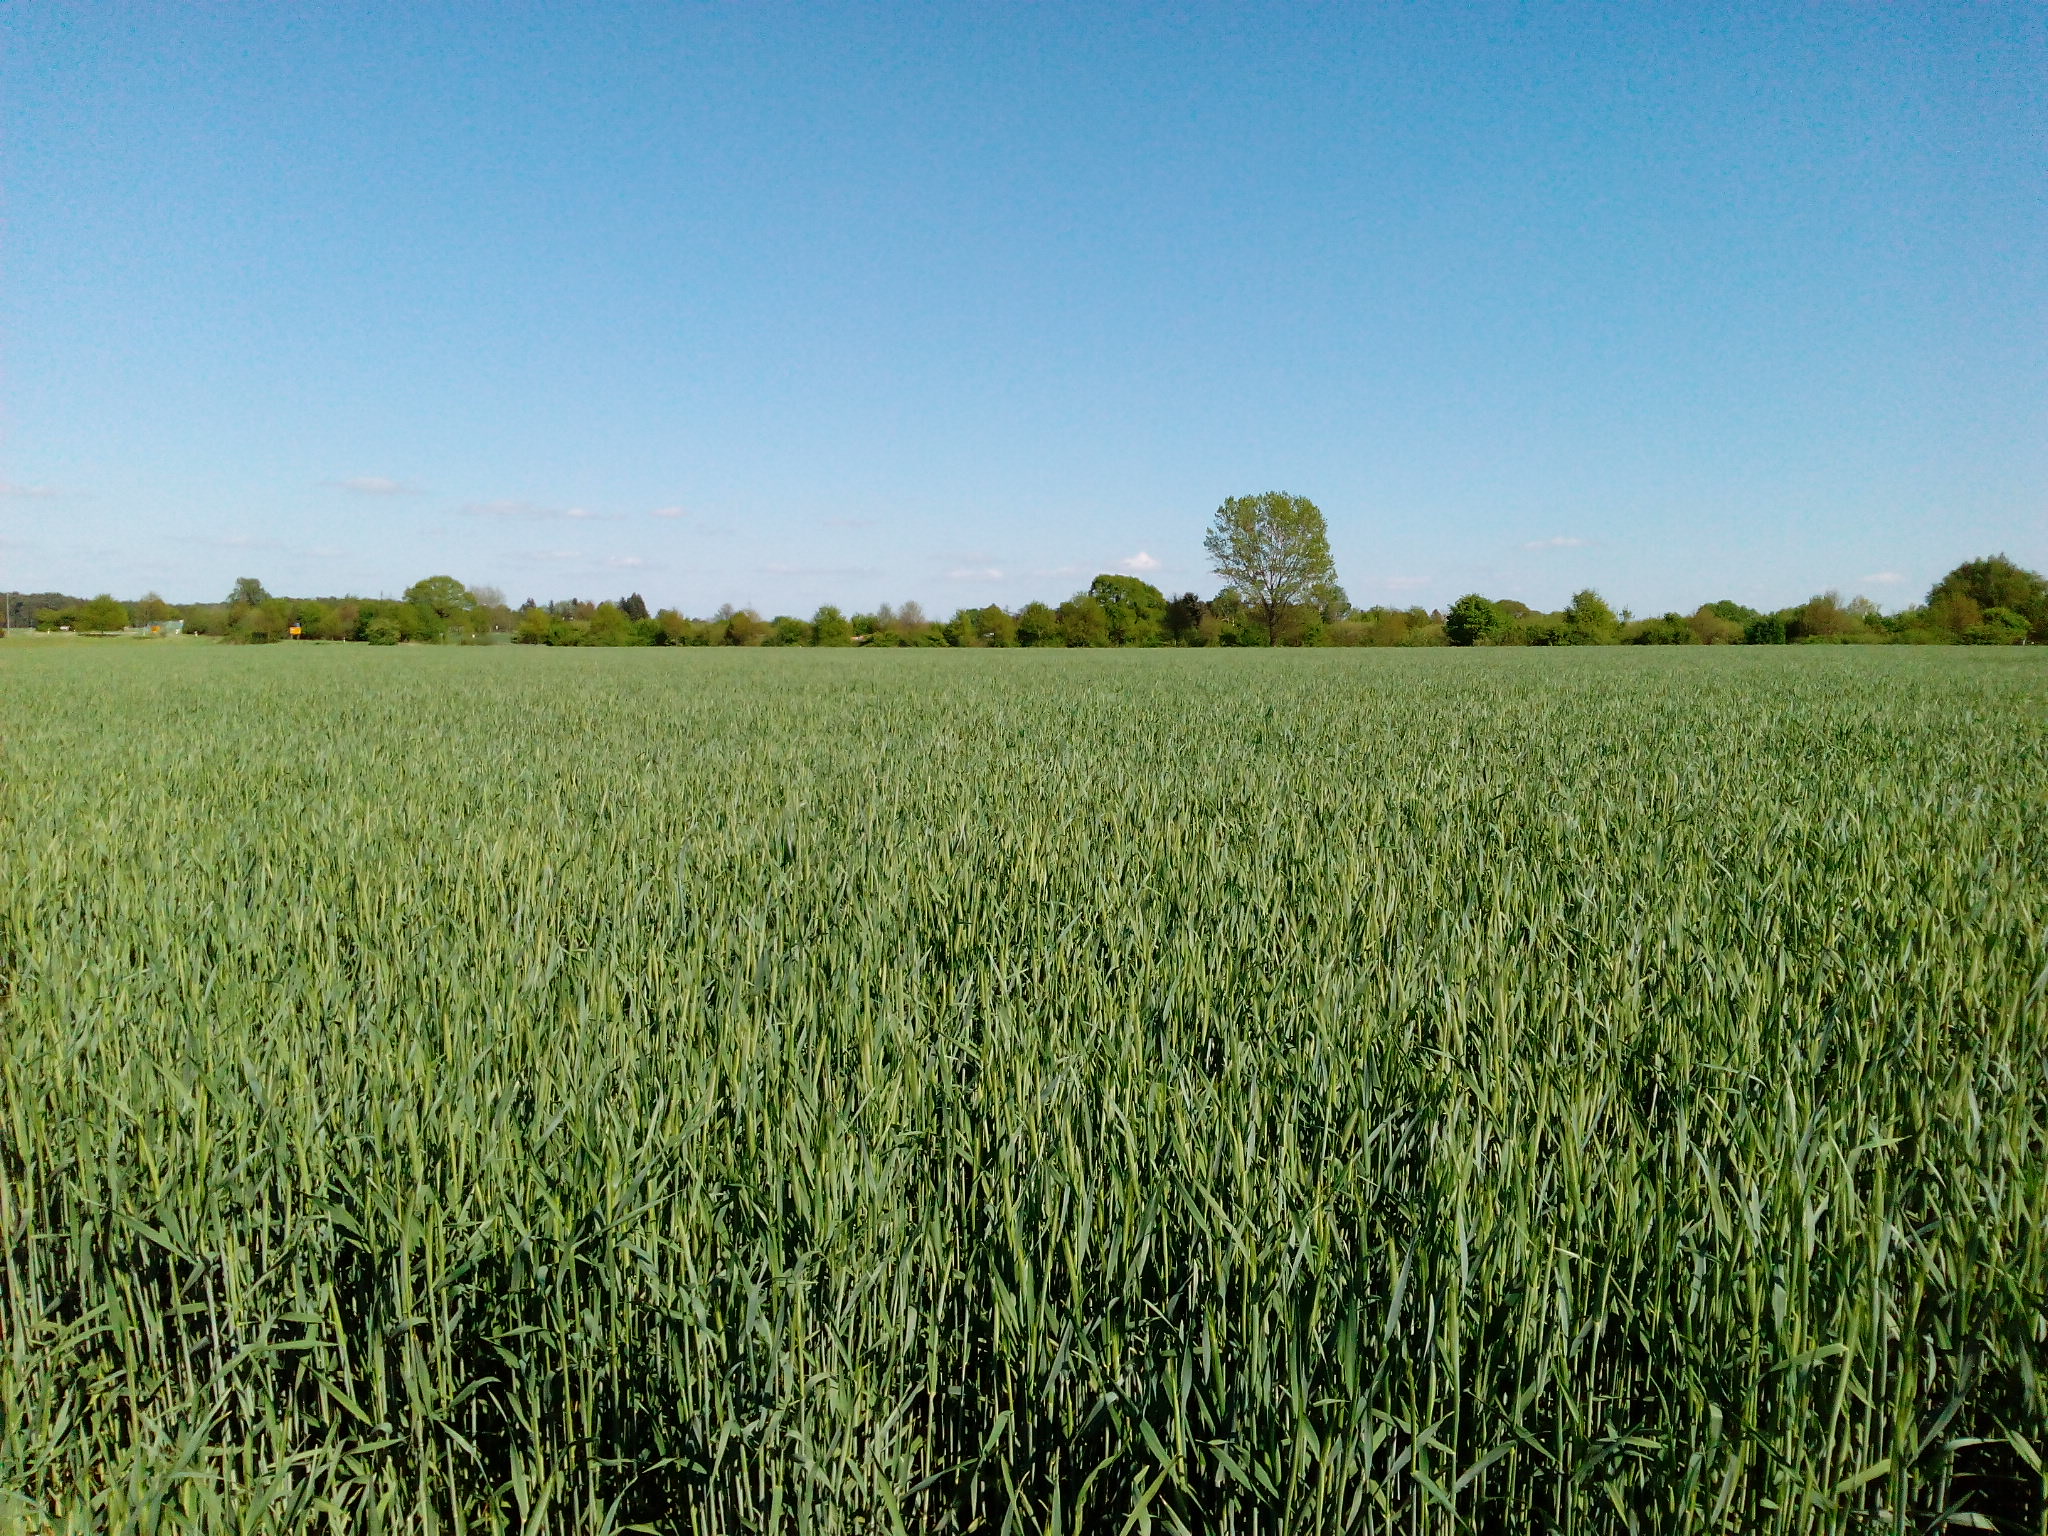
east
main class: Cropland
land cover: Rye
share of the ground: > 75 %
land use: Agriculture (excluding fallow land and kitchen gardens)
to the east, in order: Rye; Other bare soil
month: May
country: DE
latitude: 52.4852
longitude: 9.8675
